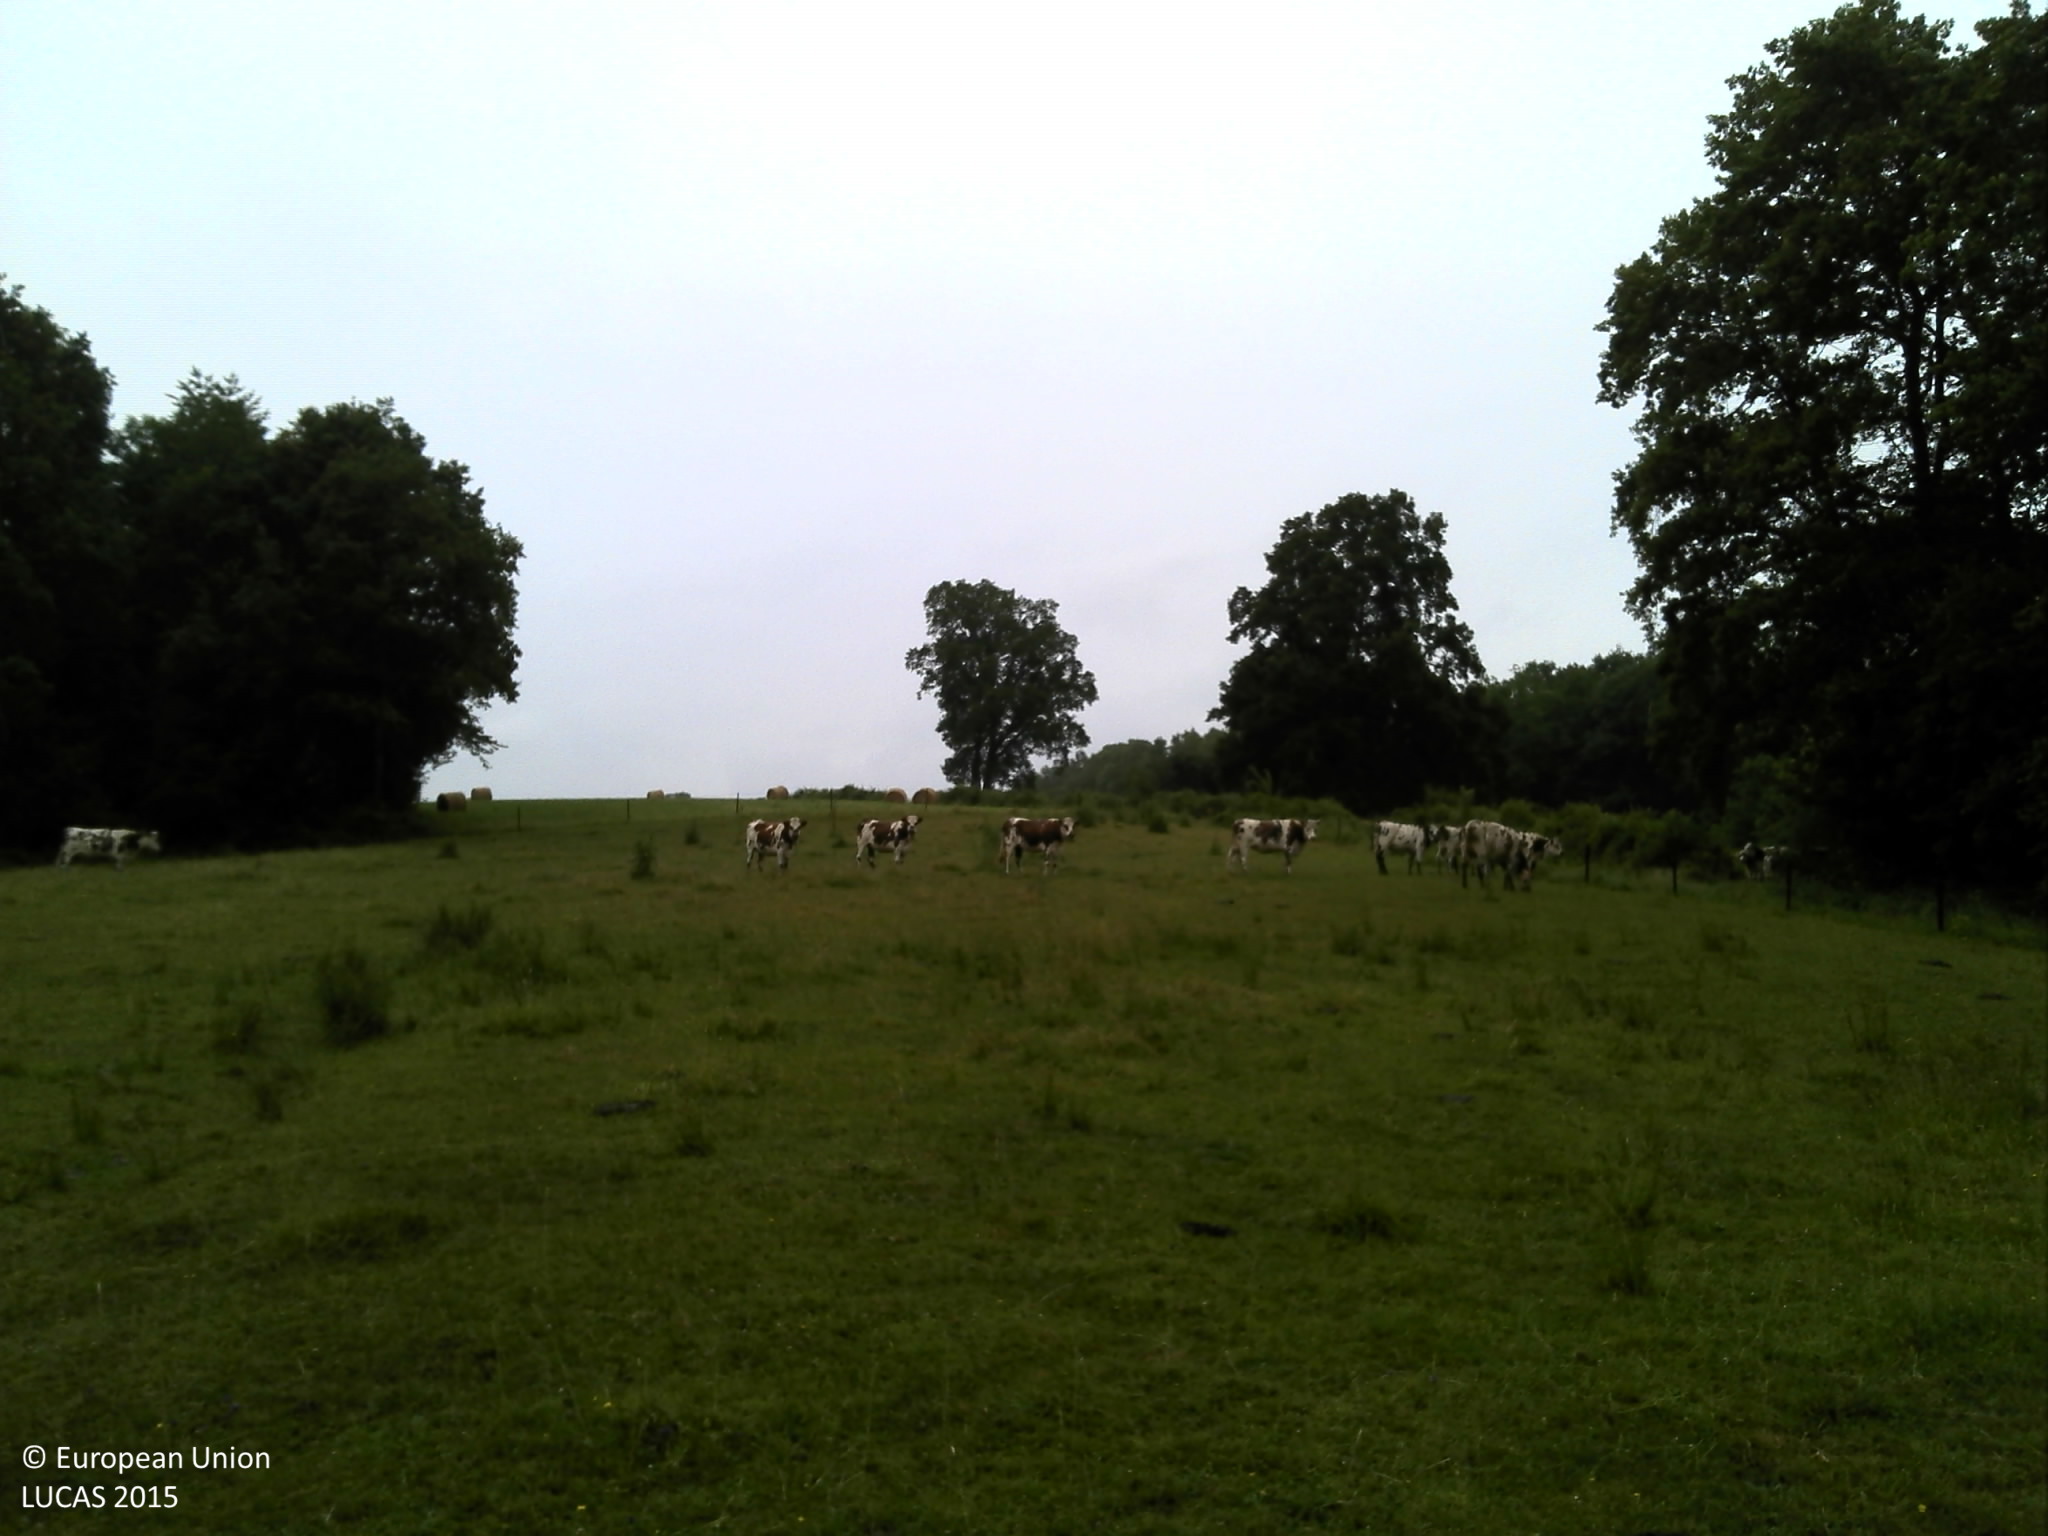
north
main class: Grassland
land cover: Grassland without tree/shrub cover
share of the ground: > 75 %
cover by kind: herbaceous plants 100 %
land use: Agriculture (excluding fallow land and kitchen gardens)
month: June
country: FR
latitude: 49.5603
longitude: 4.7849
